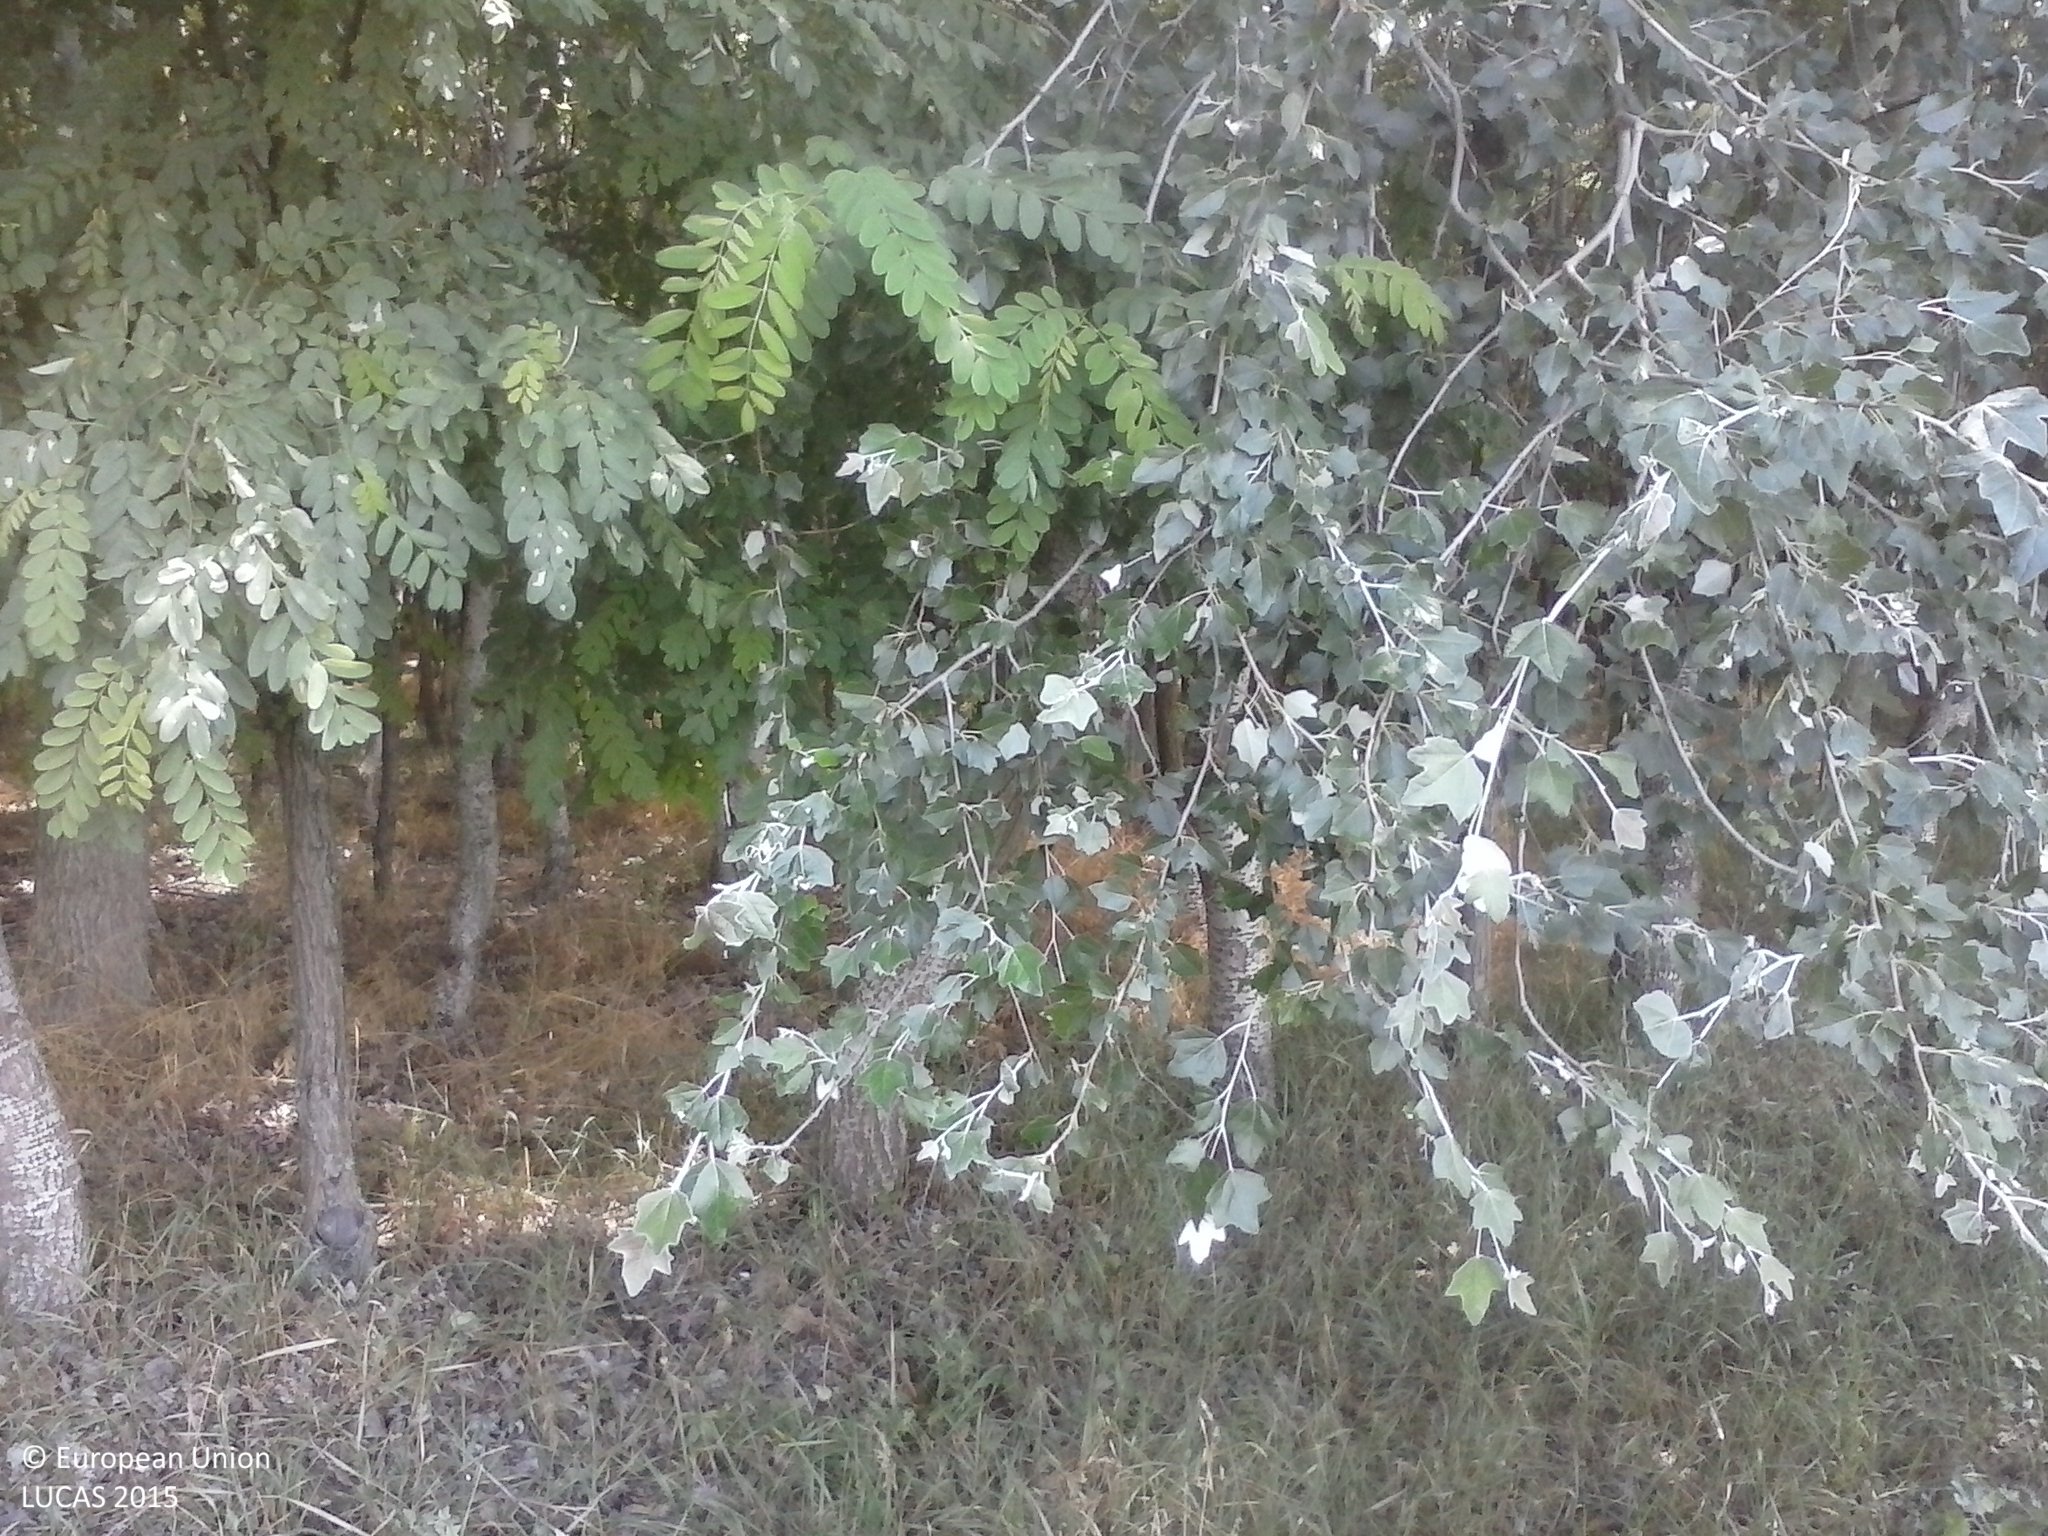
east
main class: Cropland
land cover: Lucerne
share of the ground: > 75 %
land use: Agriculture (excluding fallow land and kitchen gardens)
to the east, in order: Lucerne; Fences; Tracks; Broadleaved woodland; Grassland without tree/shrub cover
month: July
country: HU
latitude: 46.2850
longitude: 19.5567
